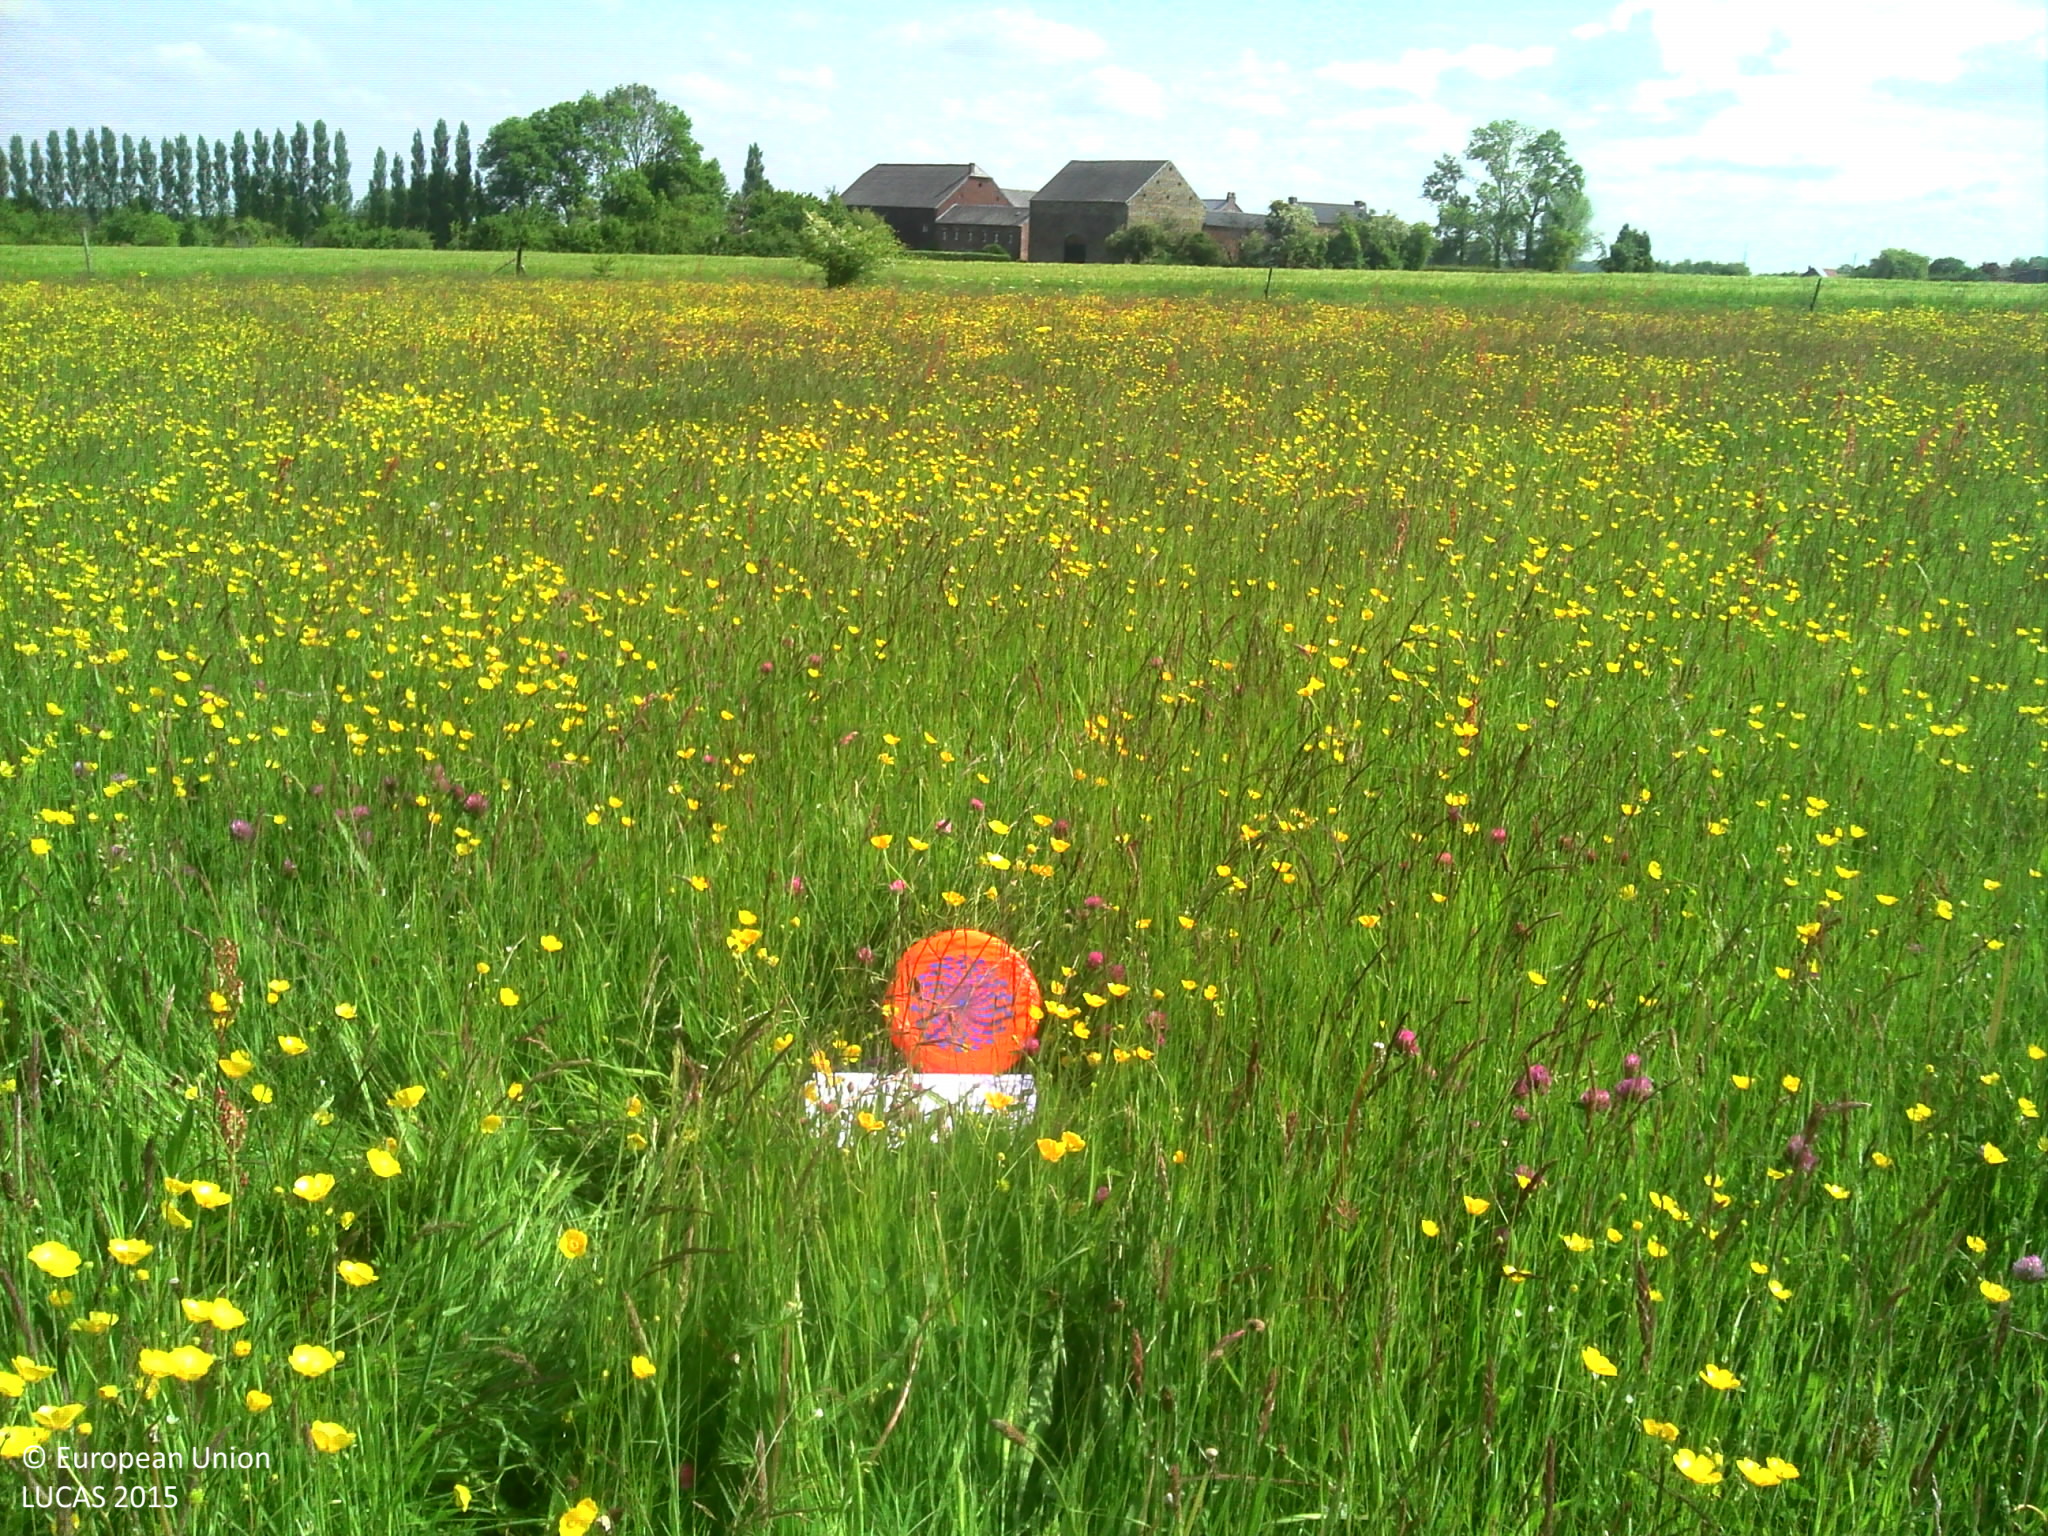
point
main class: Grassland
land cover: Grassland without tree/shrub cover
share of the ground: > 75 %
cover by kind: herbaceous plants 100 %
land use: Agriculture (excluding fallow land and kitchen gardens)
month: May
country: BE
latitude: 50.4589
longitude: 5.1378
